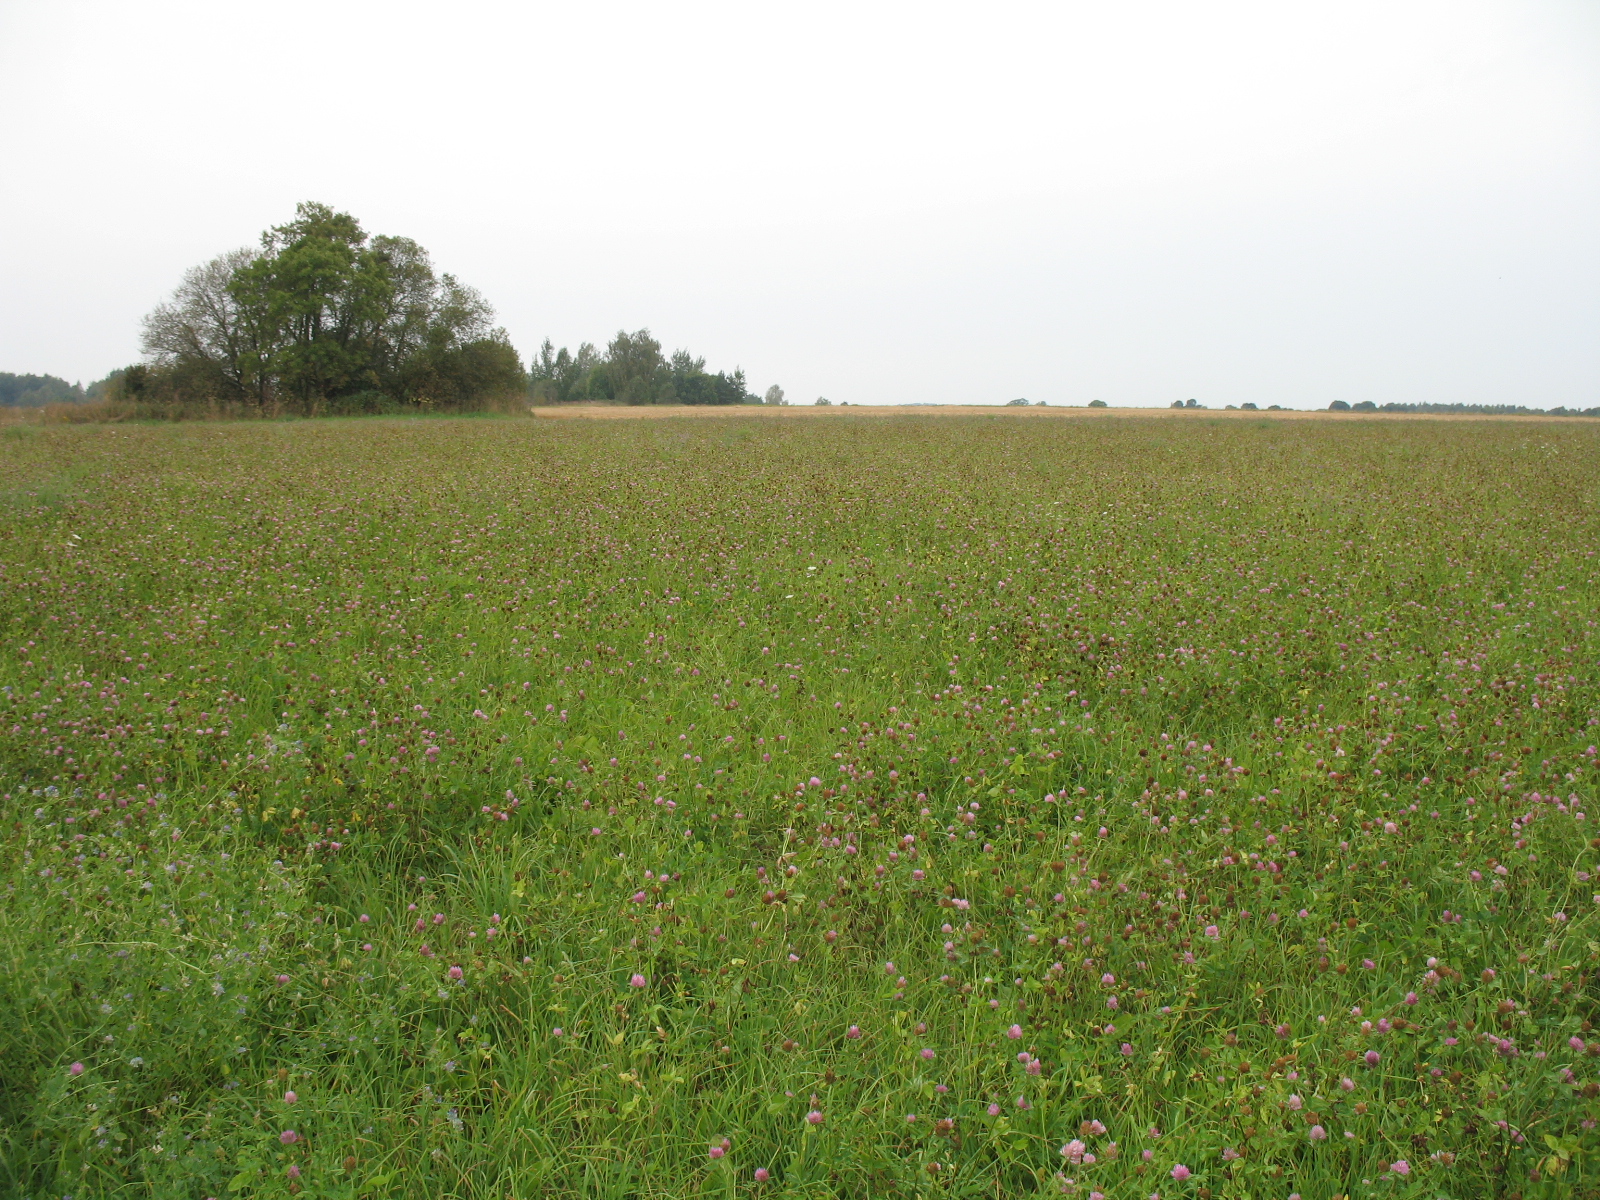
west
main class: Cropland
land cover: Clovers
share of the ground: > 75 %
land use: Agriculture (excluding fallow land and kitchen gardens)
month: August
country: LV
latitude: 56.3182
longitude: 25.9618
